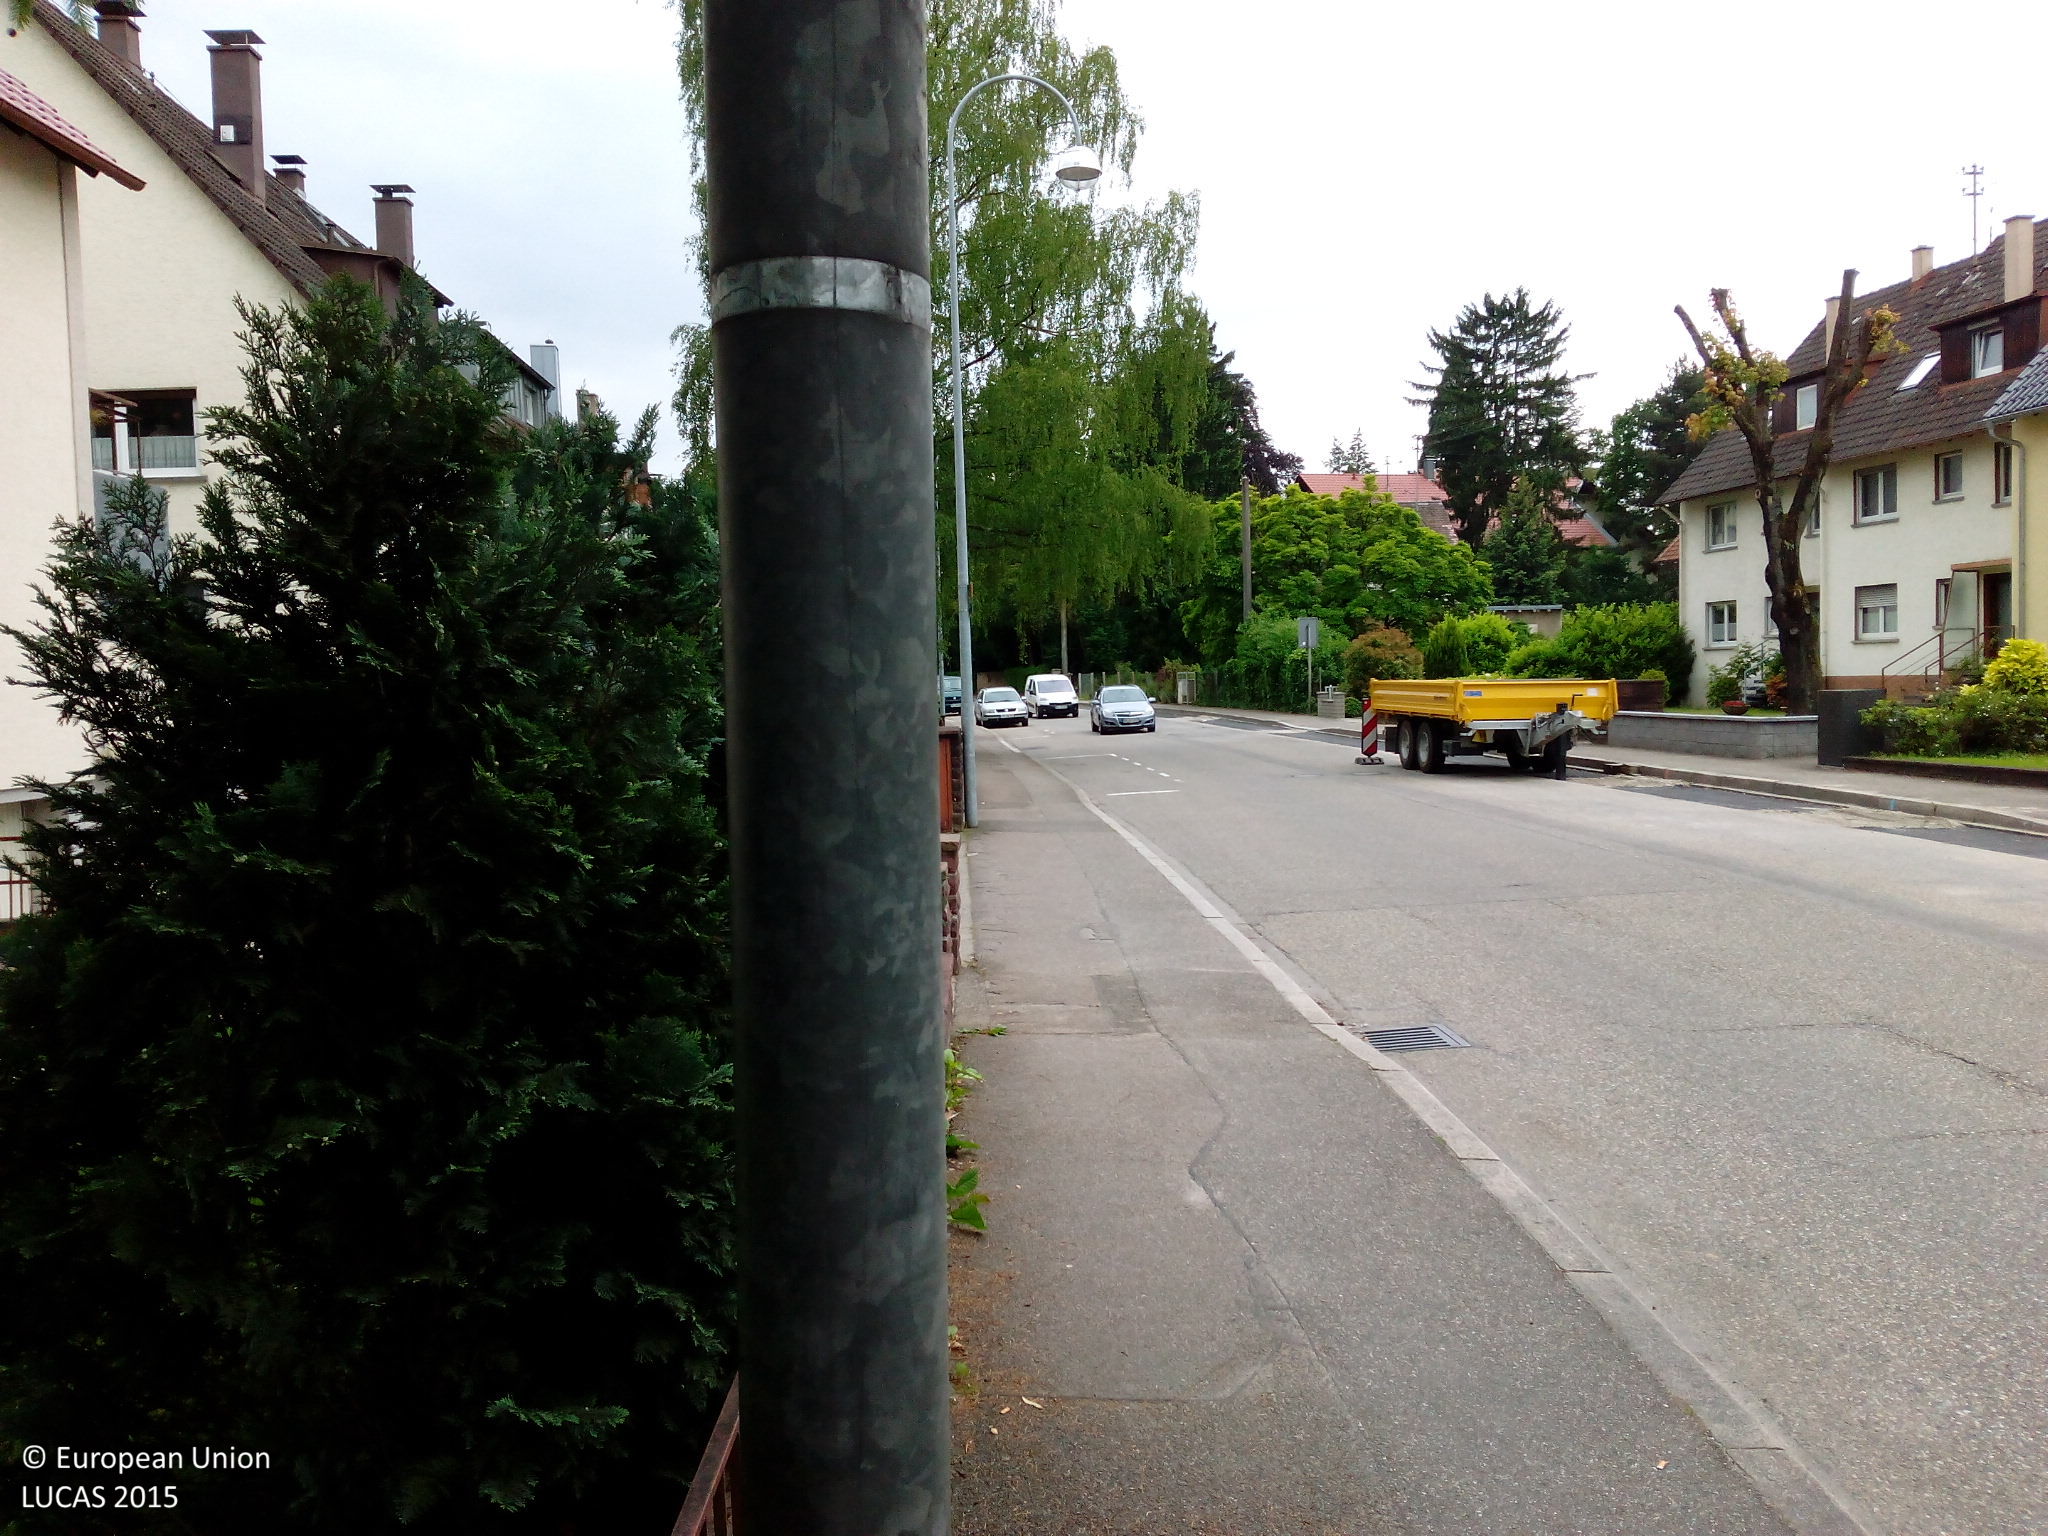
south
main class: Grassland
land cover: Grassland without tree/shrub cover
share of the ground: > 75 %
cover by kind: herbaceous plants 90 %, unconsolidated bare surface 10 %
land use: Residential
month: May
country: DE
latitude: 48.7846
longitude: 8.1905
